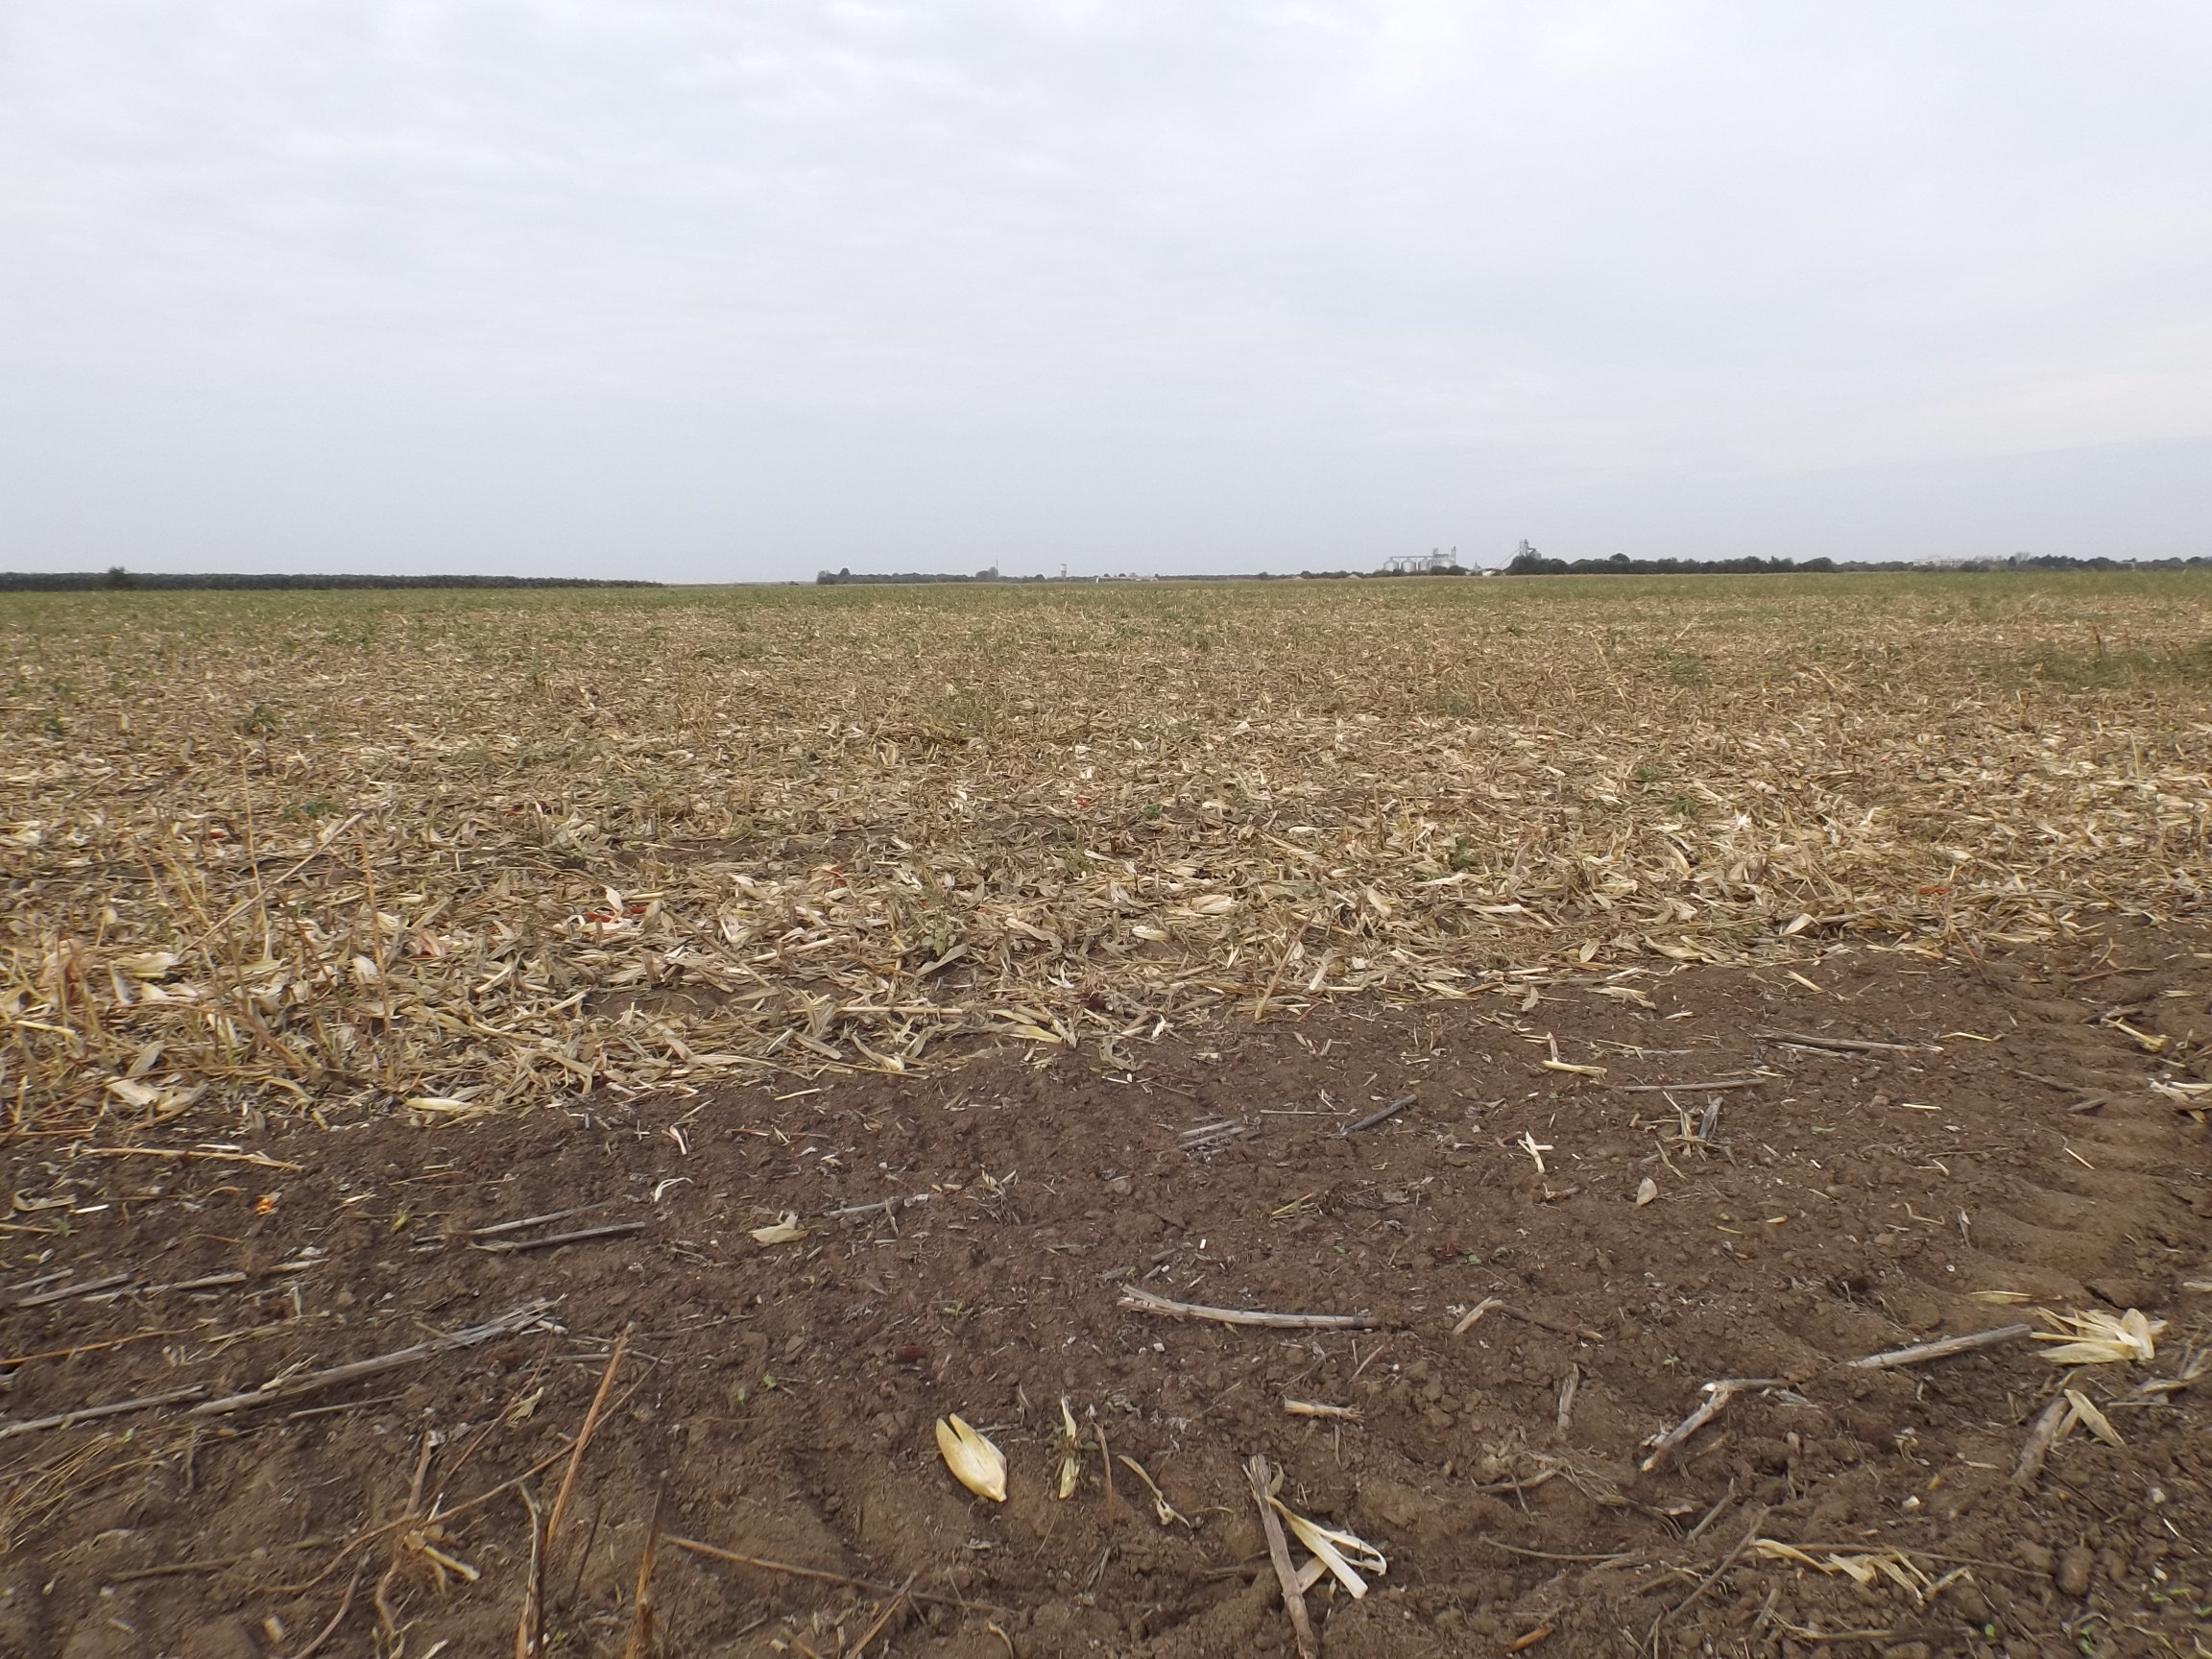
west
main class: Cropland
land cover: Sunflower
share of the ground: < 10 %
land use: Agriculture (excluding fallow land and kitchen gardens)
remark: Harvested field
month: October
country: BG
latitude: 43.9491
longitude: 26.8785
